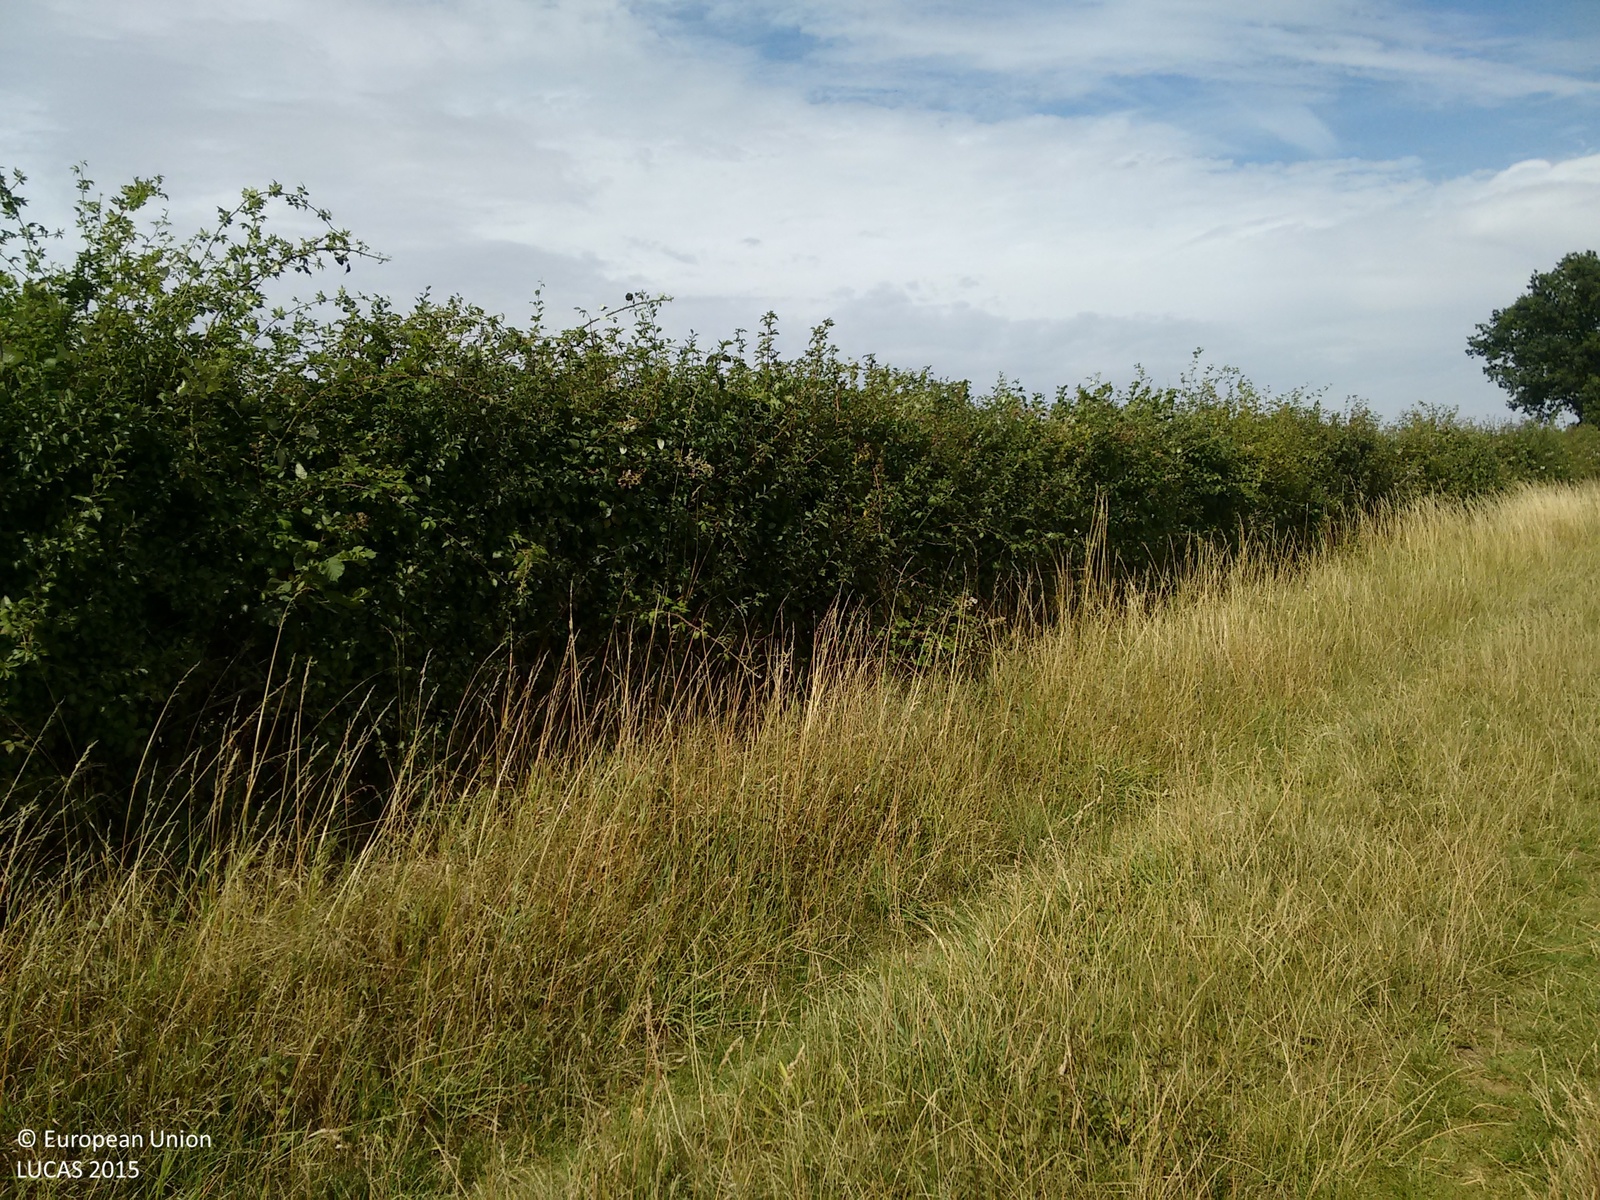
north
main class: Cropland
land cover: Dry pulses
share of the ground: > 75 %
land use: Agriculture (excluding fallow land and kitchen gardens)
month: August
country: GB
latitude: 51.9795
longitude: 0.5236
